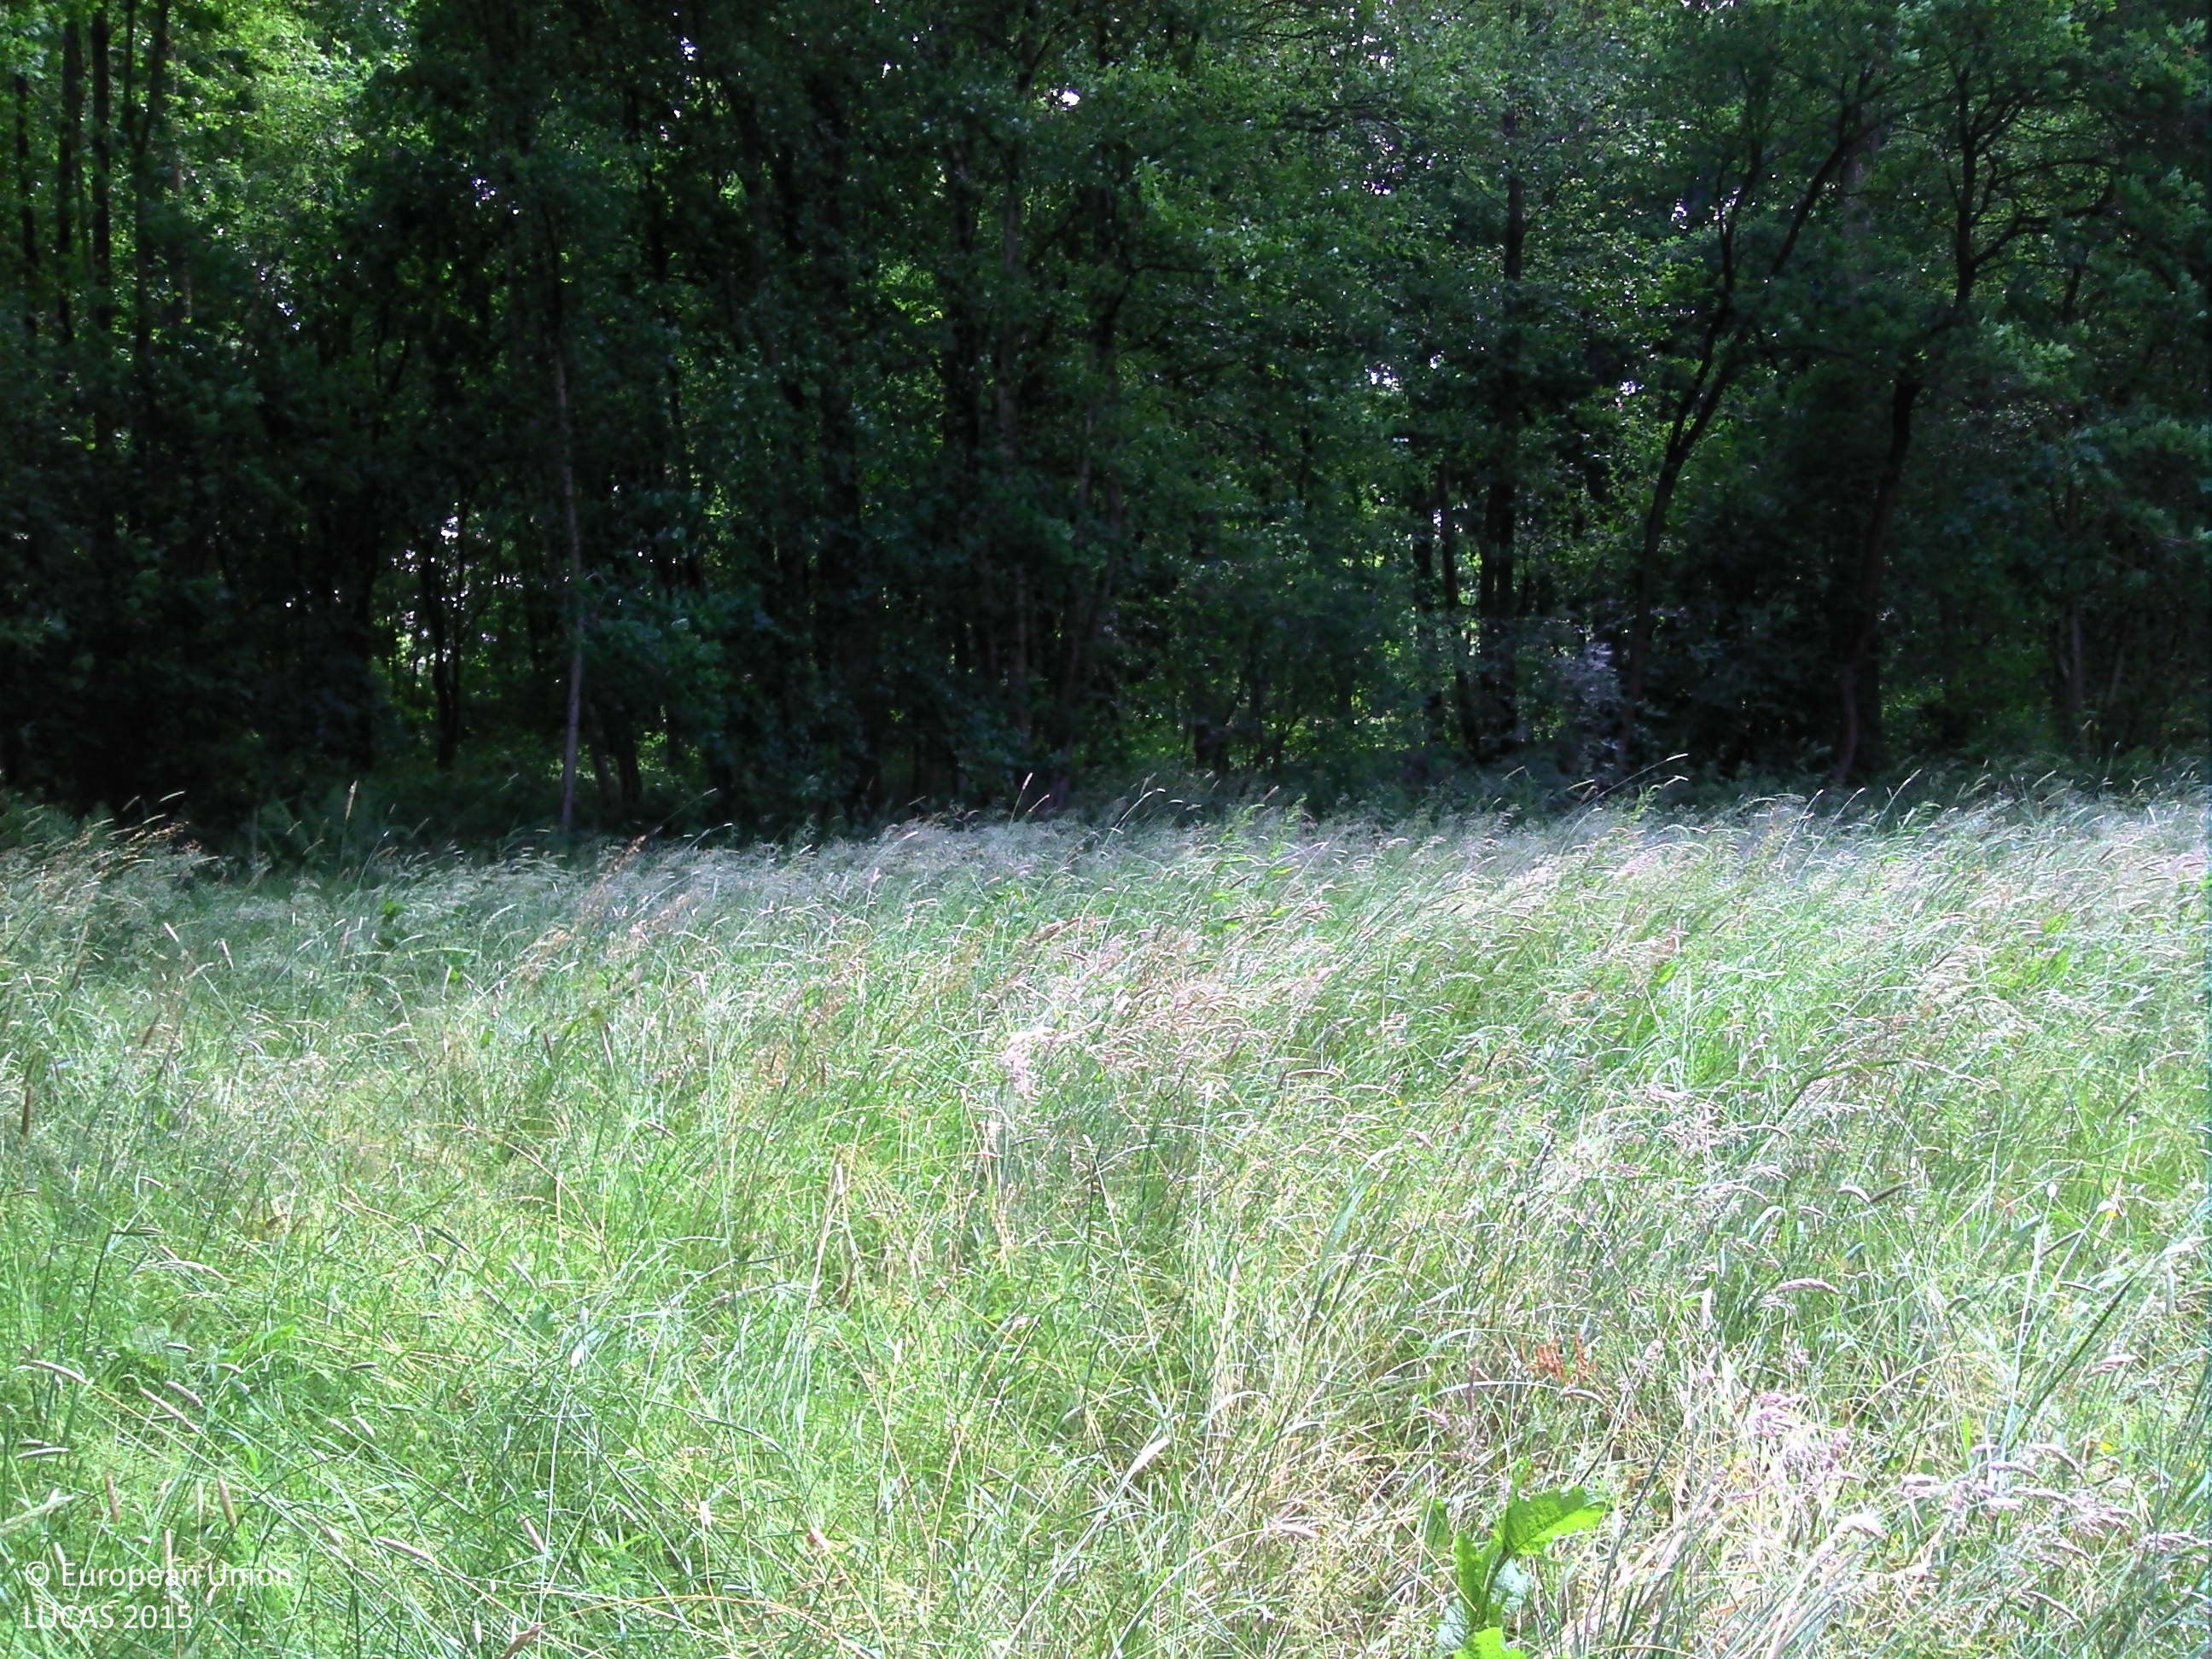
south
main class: Grassland
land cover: Grassland without tree/shrub cover
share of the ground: > 75 %
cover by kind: herbaceous plants 100 %
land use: Agriculture (excluding fallow land and kitchen gardens)
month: June
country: BE
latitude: 51.0946
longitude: 5.7292
